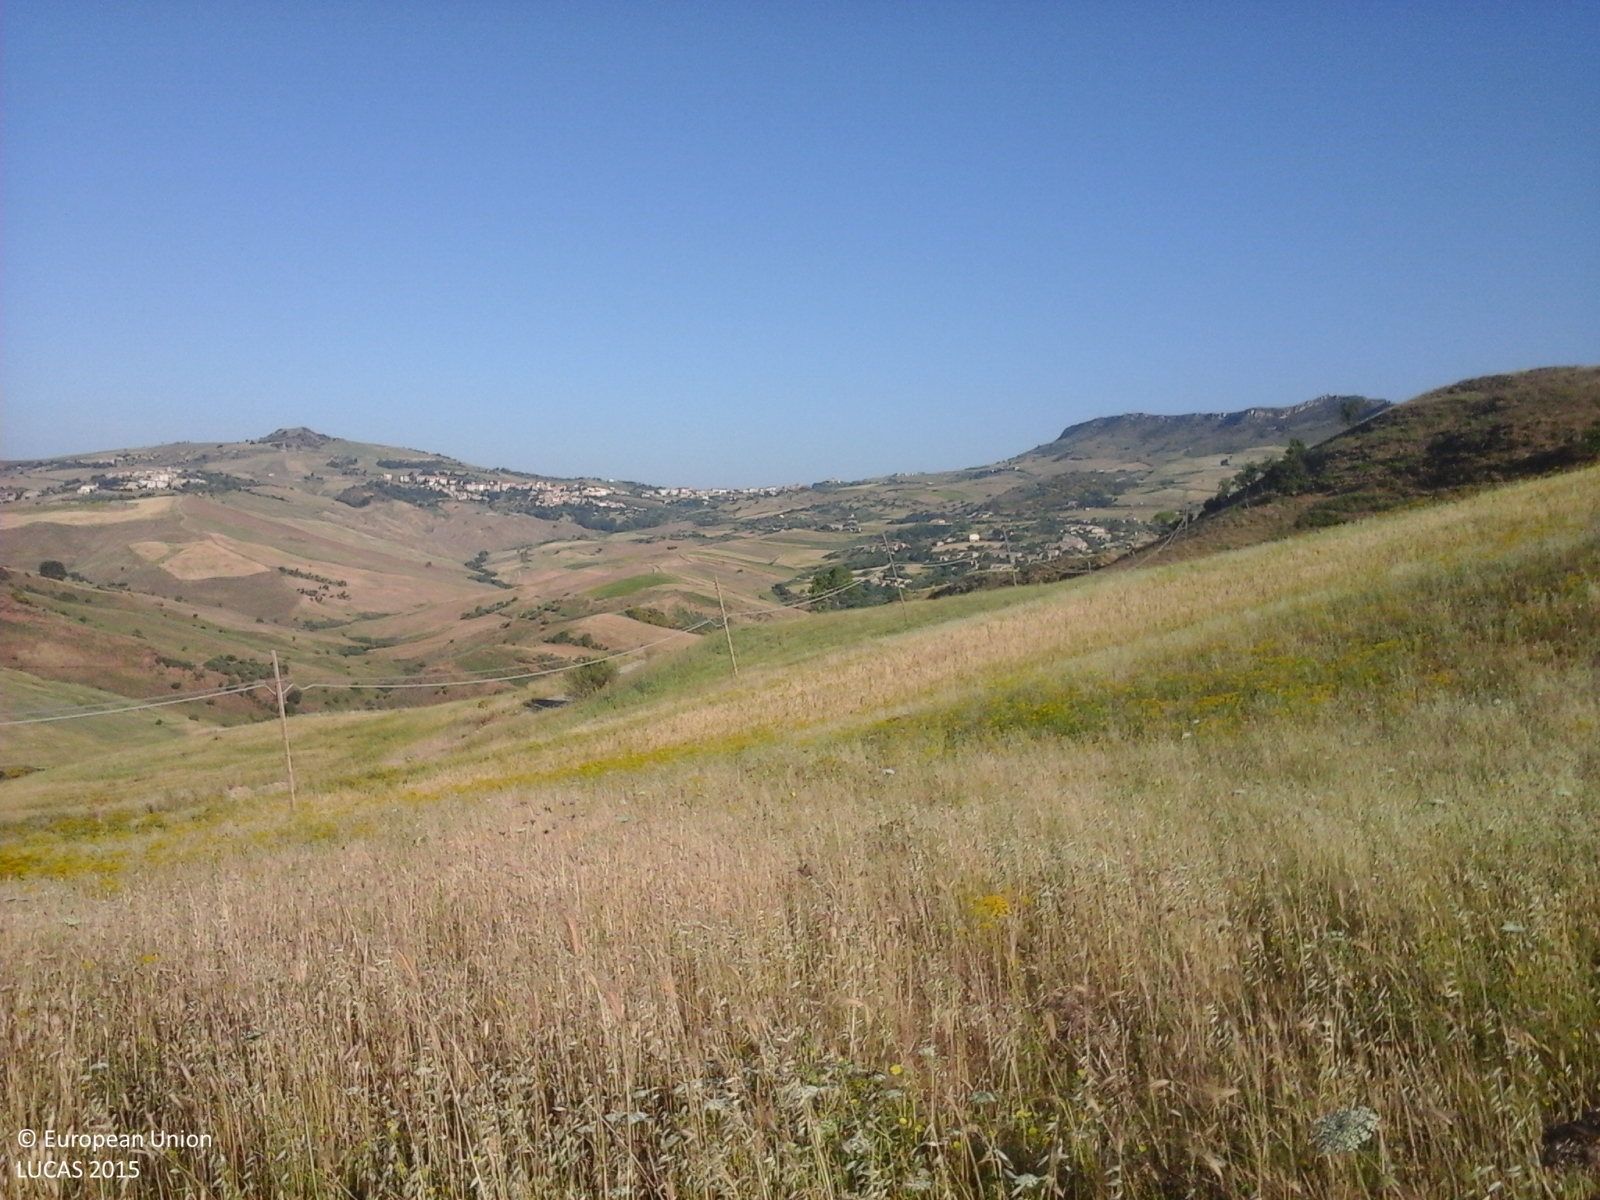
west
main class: Grassland
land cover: Grassland without tree/shrub cover
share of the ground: > 75 %
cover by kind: herbaceous plants 100 %
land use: Agriculture (excluding fallow land and kitchen gardens)
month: June
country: IT
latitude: 37.7666
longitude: 14.1365
